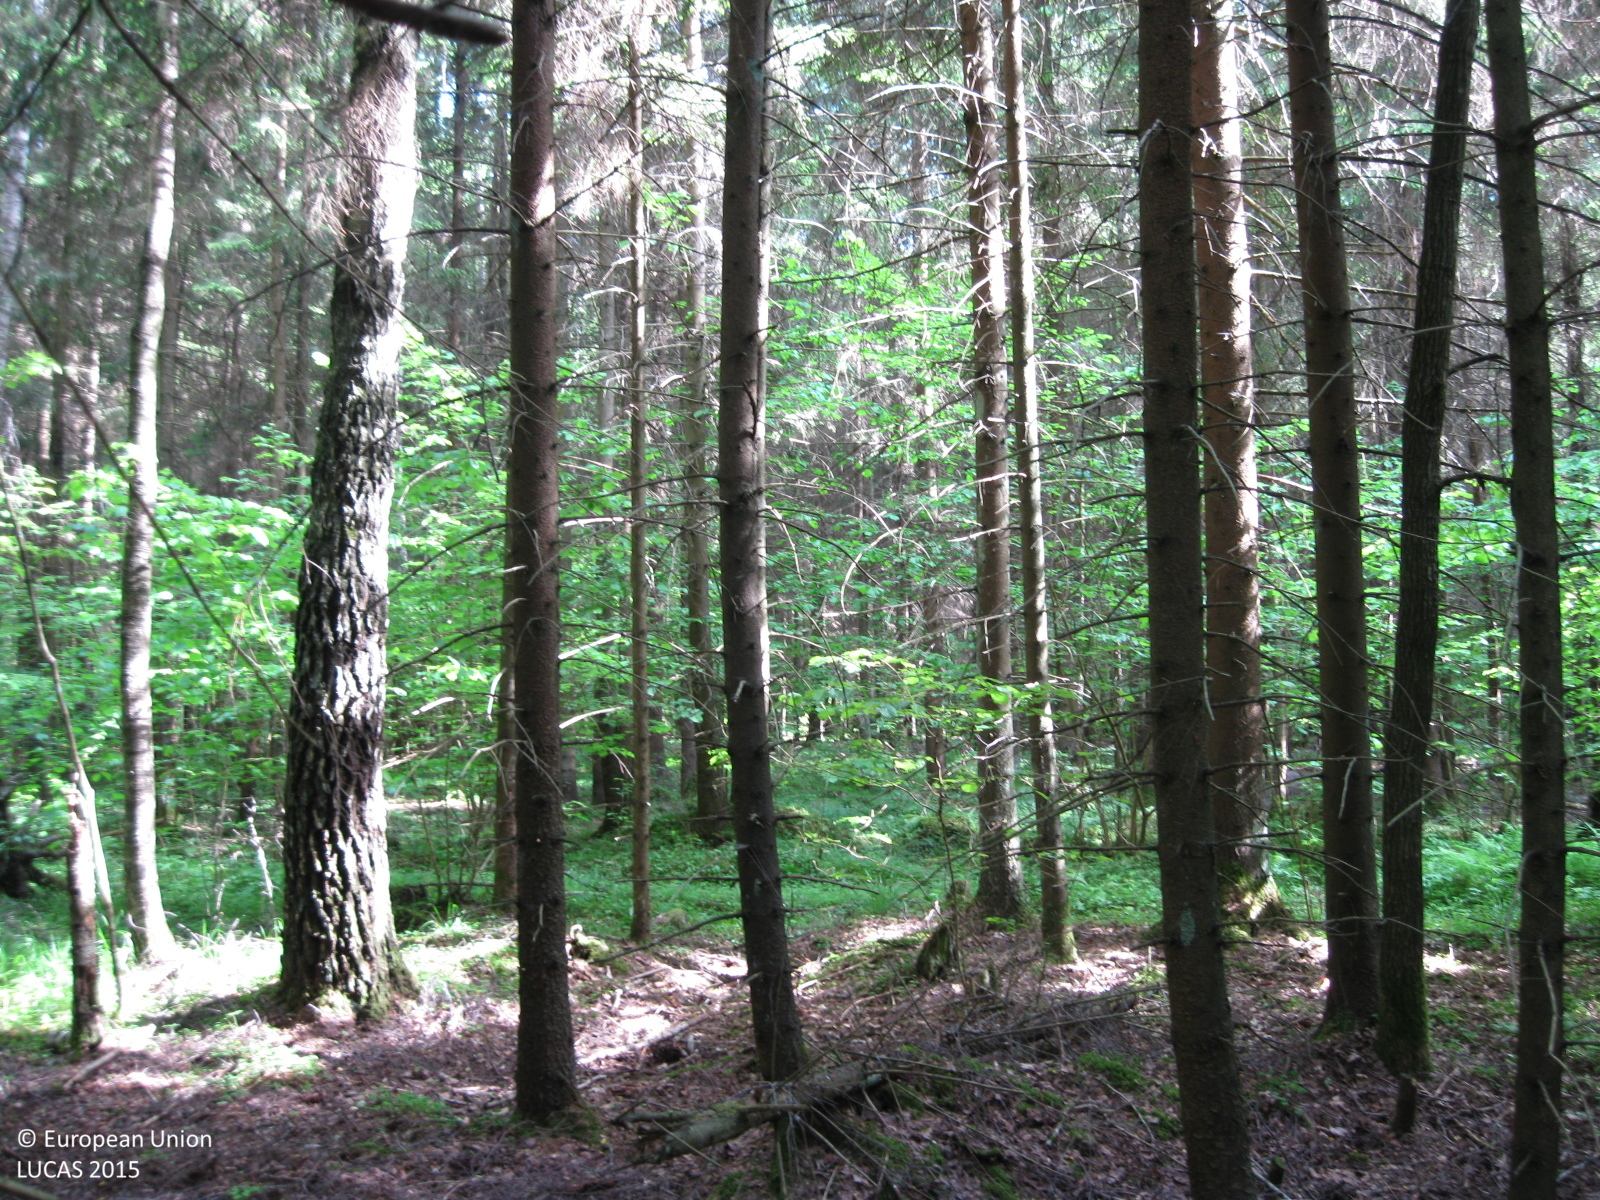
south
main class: Woodland
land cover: Spruce dominated mixed woodland
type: hemiboreal forest and nemoral coniferous forest and mixed broadleaved-coniferous forest
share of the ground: > 75 %
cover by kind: coniferous forest trees 65 %, broadleaved forest trees 25 %, unconsolidated bare surface 10 %
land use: Forestry
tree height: > 5 m
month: June
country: LT
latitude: 55.6030
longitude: 23.6200
